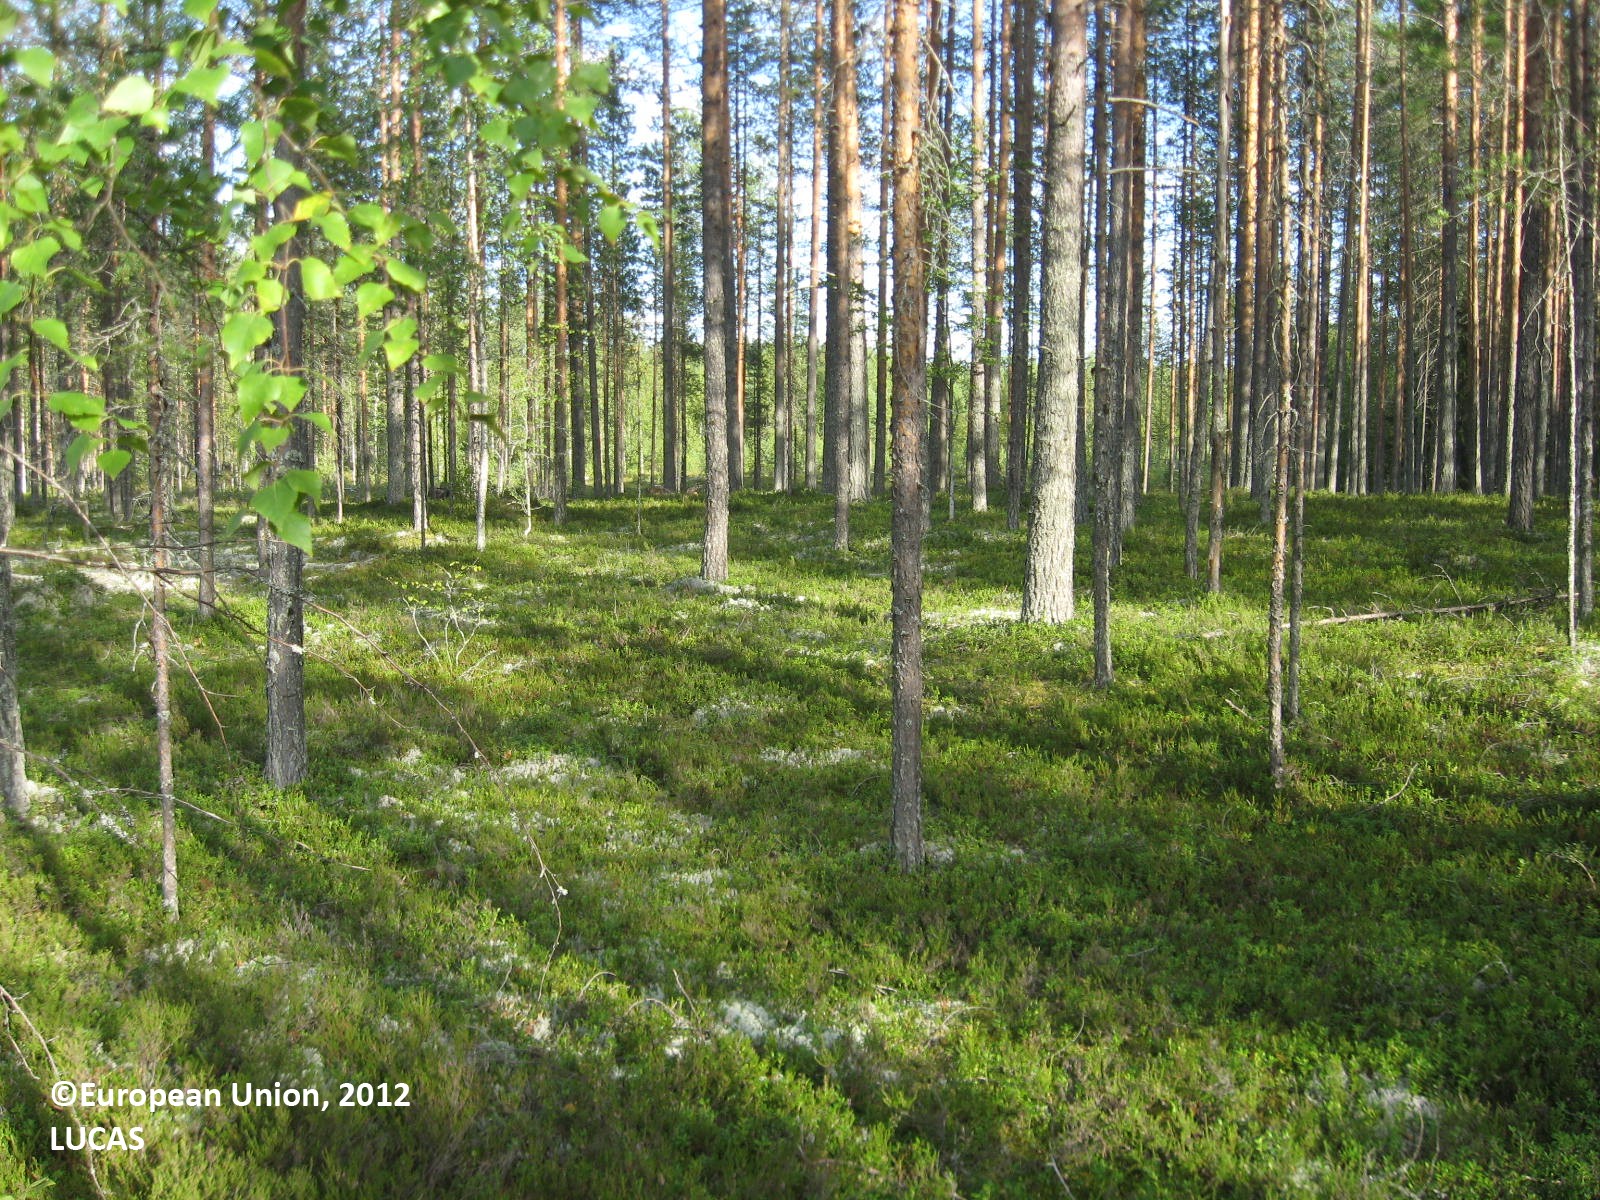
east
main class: Woodland
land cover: Pine dominated coniferous woodland
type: boreal forest
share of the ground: > 75 %
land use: Forestry
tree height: > 5 m
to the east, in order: Pine dominated coniferous woodland; Broadleaved woodland; Pine dominated coniferous woodland; Ditches and canals; Pine dominated coniferous woodland; Ditches and canals; Pine dominated coniferous woodland; Ditches and canals; Pine dominated coniferous woodland
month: August
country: FI
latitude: 63.5988
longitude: 29.6433
